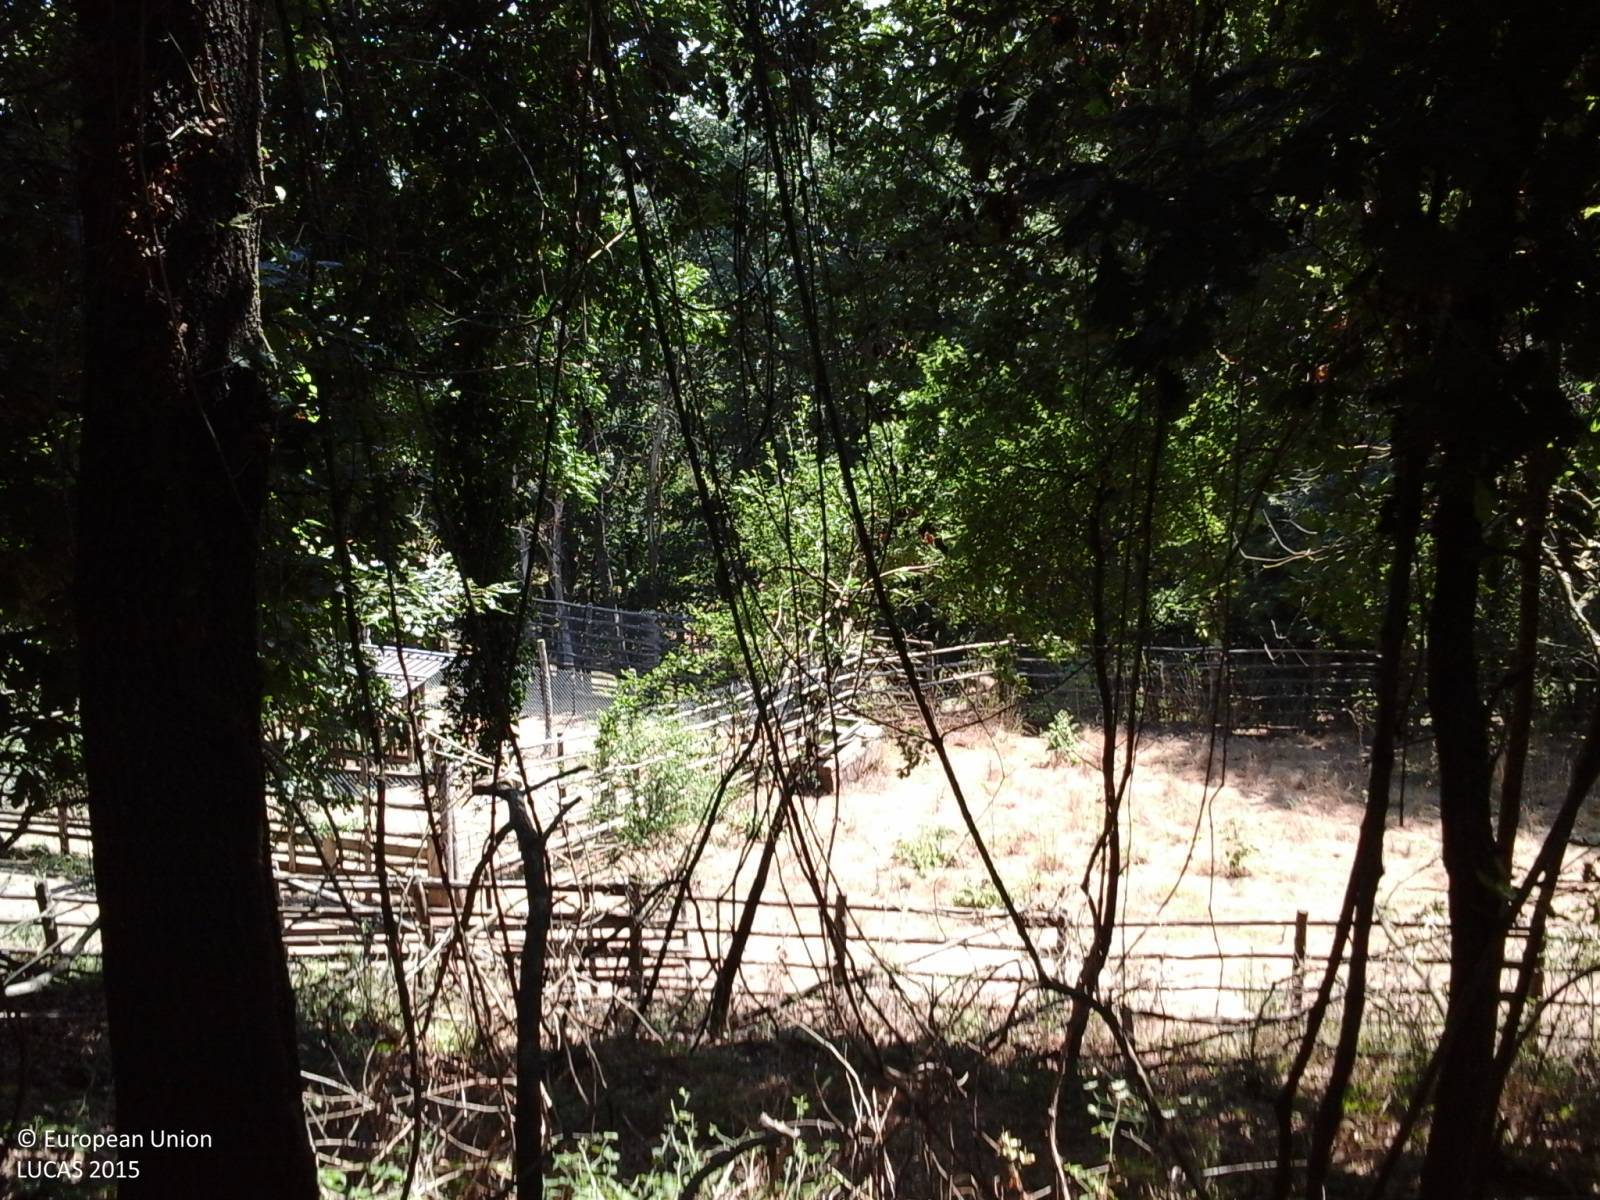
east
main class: Woodland
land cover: Broadleaved woodland
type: thermophilous deciduous forest
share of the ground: > 75 %
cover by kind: broadleaved forest trees 100 %
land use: Agriculture (excluding fallow land and kitchen gardens)
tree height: > 5 m
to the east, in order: Broadleaved woodland; Fences; Grassland without tree/shrub cover; Fences; Broadleaved woodland; Fences; Grassland without tree/shrub cover; Fences; Grassland with sparse tree/shrub cover; Fences; Nuts trees
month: August
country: IT
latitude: 42.2138
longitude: 12.2331
